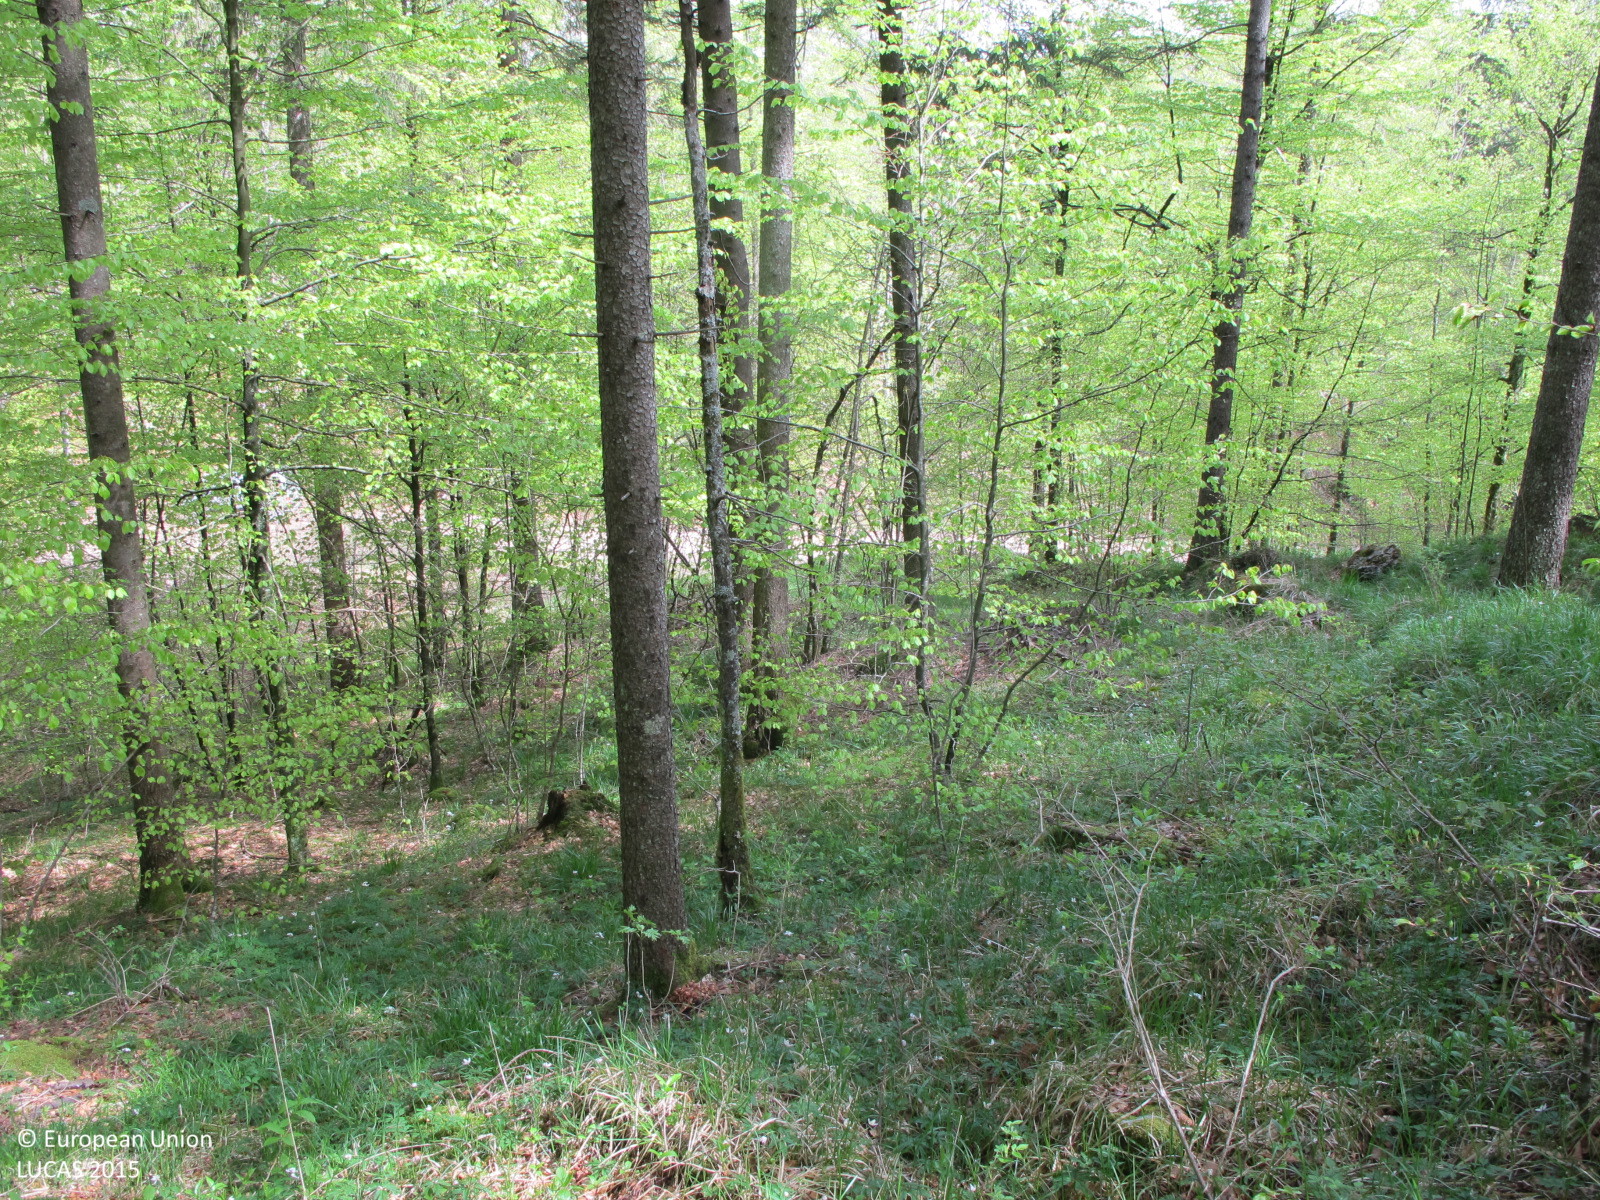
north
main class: Woodland
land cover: Broadleaved woodland
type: mountainous beech forest
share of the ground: > 75 %
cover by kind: broadleaved forest trees 90 %, coniferous forest trees 5 %, herbaceous plants 5 %
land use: Forestry
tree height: > 5 m
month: May
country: HR
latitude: 45.3469
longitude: 14.2451
